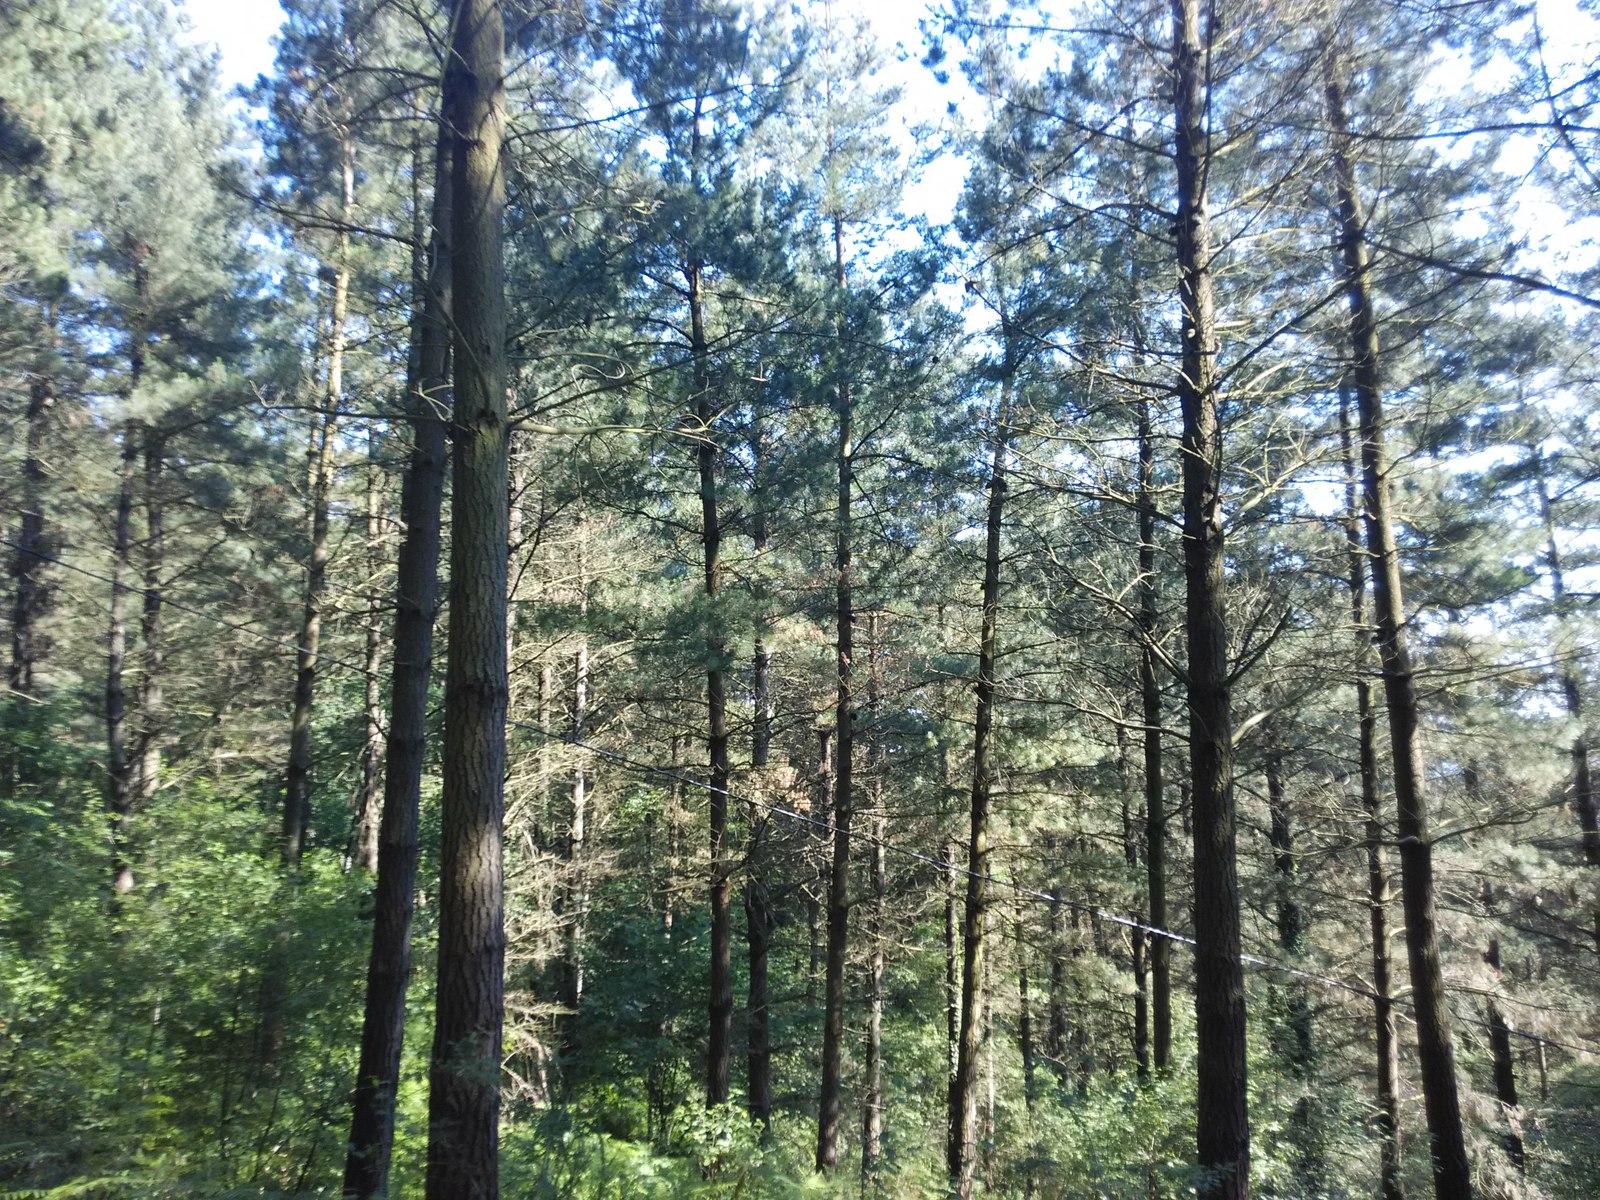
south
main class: Woodland
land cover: Pine dominated coniferous woodland
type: exotic forest
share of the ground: > 75 %
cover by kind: coniferous forest trees 100 %
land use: Forestry
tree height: > 5 m
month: June
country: ES
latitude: 43.0815
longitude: -2.4939
